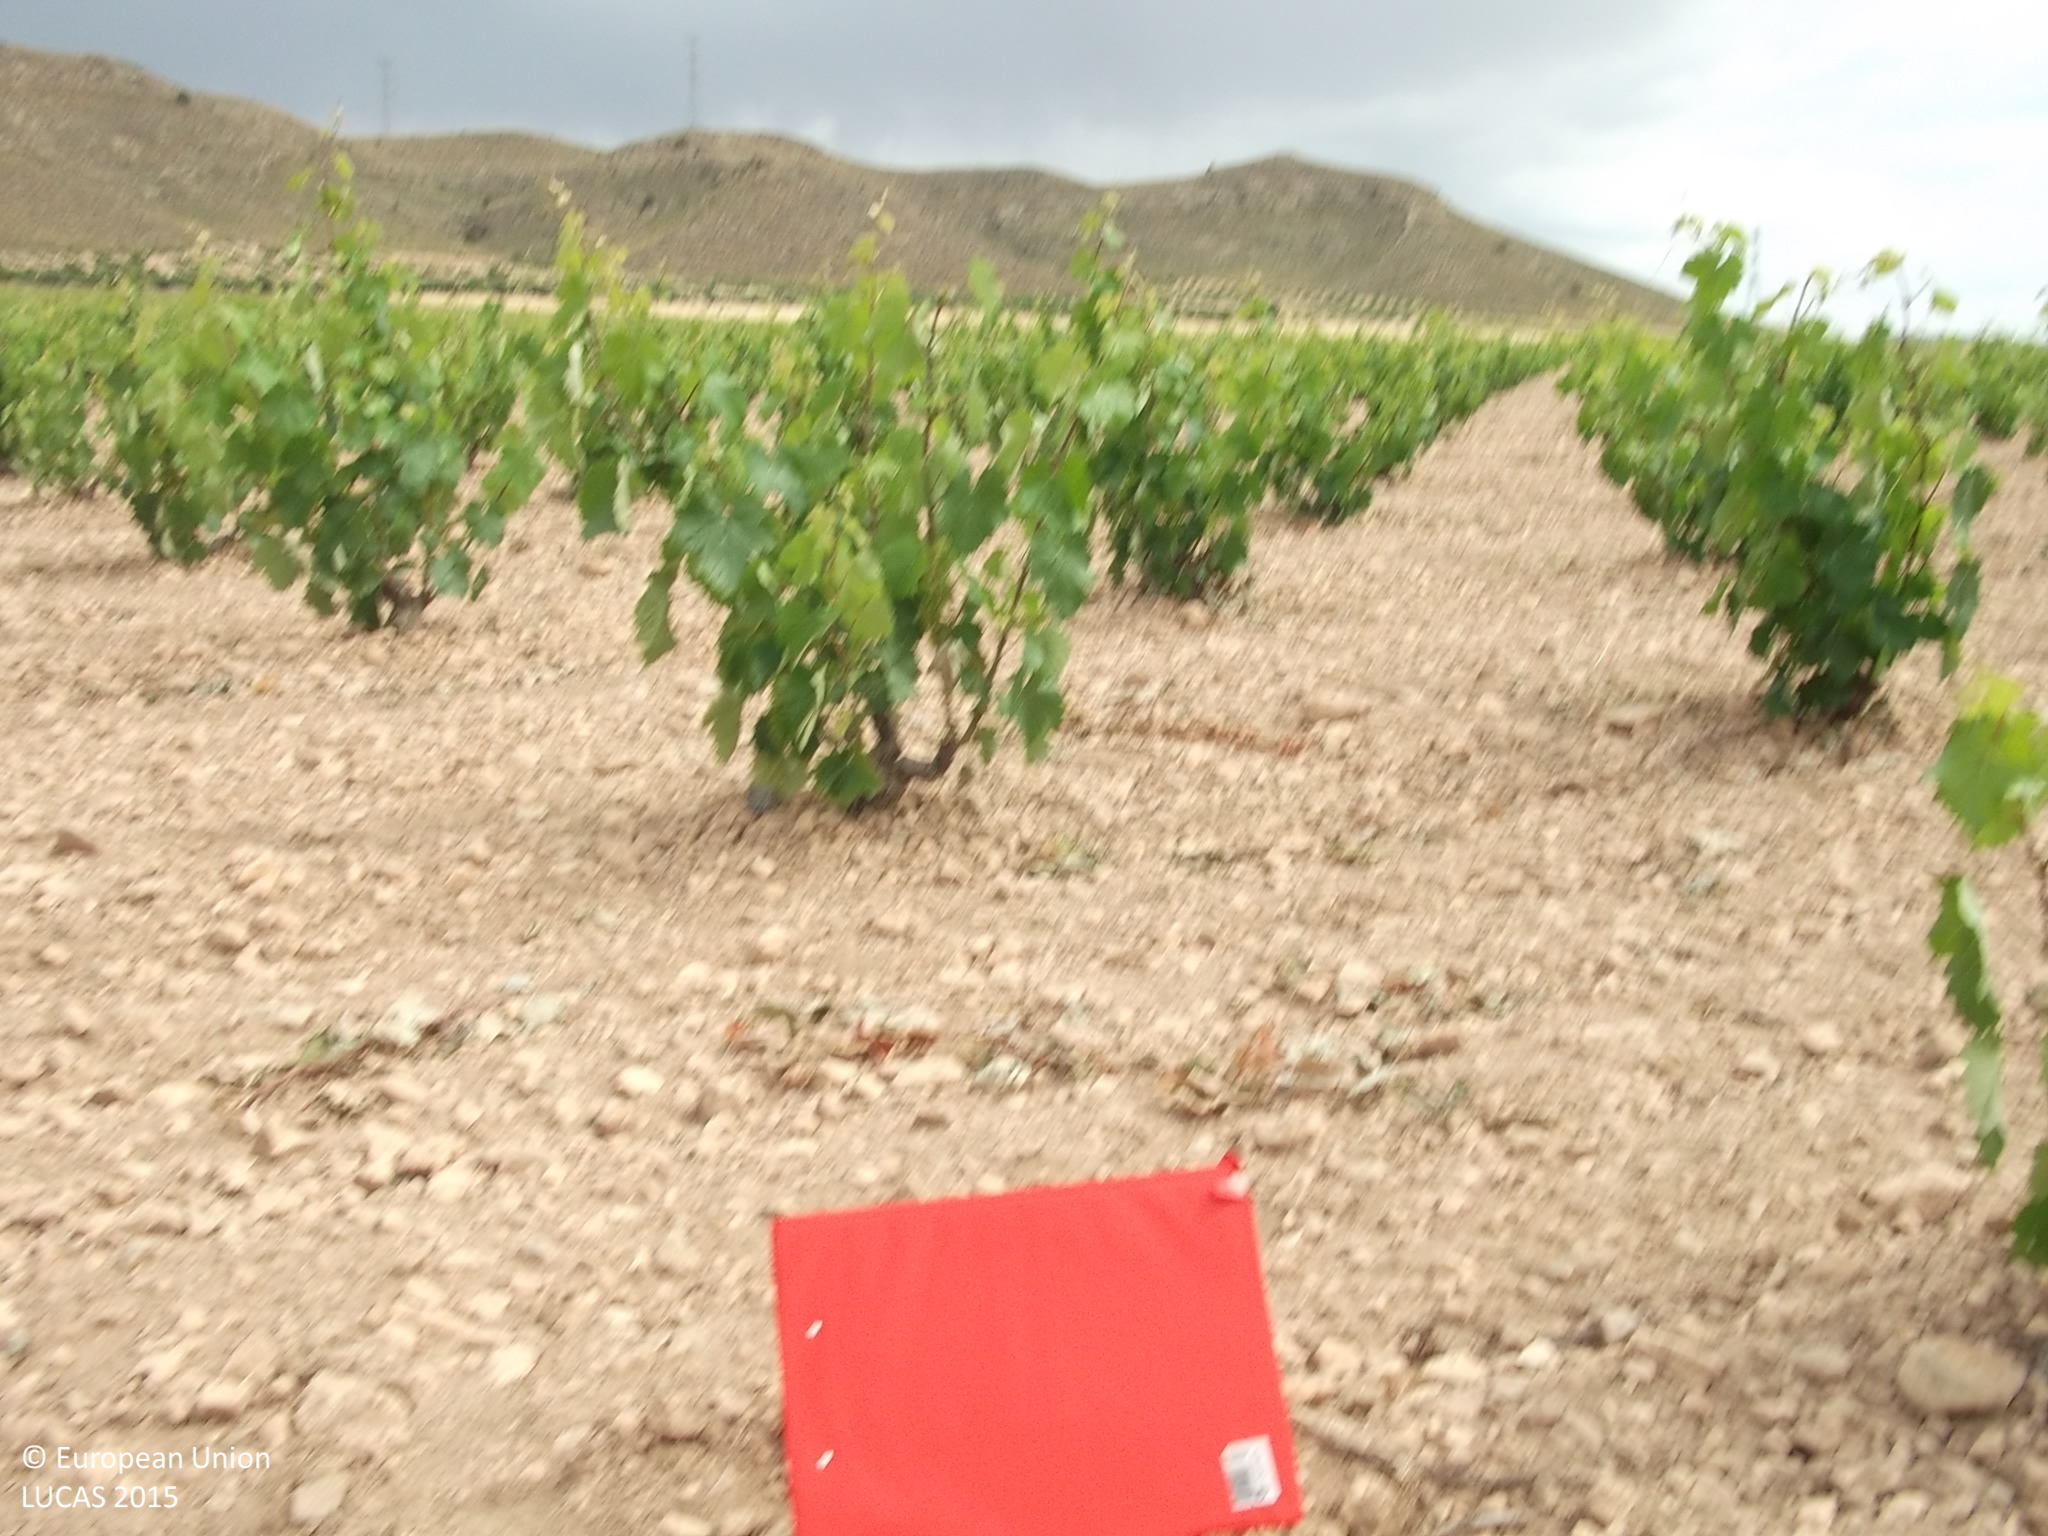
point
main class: Cropland
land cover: Vineyards
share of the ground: 10 - 25 %
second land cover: Other bare soil
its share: > 75 %
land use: Agriculture (excluding fallow land and kitchen gardens)
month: May
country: ES
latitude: 38.5277
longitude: -1.3591
